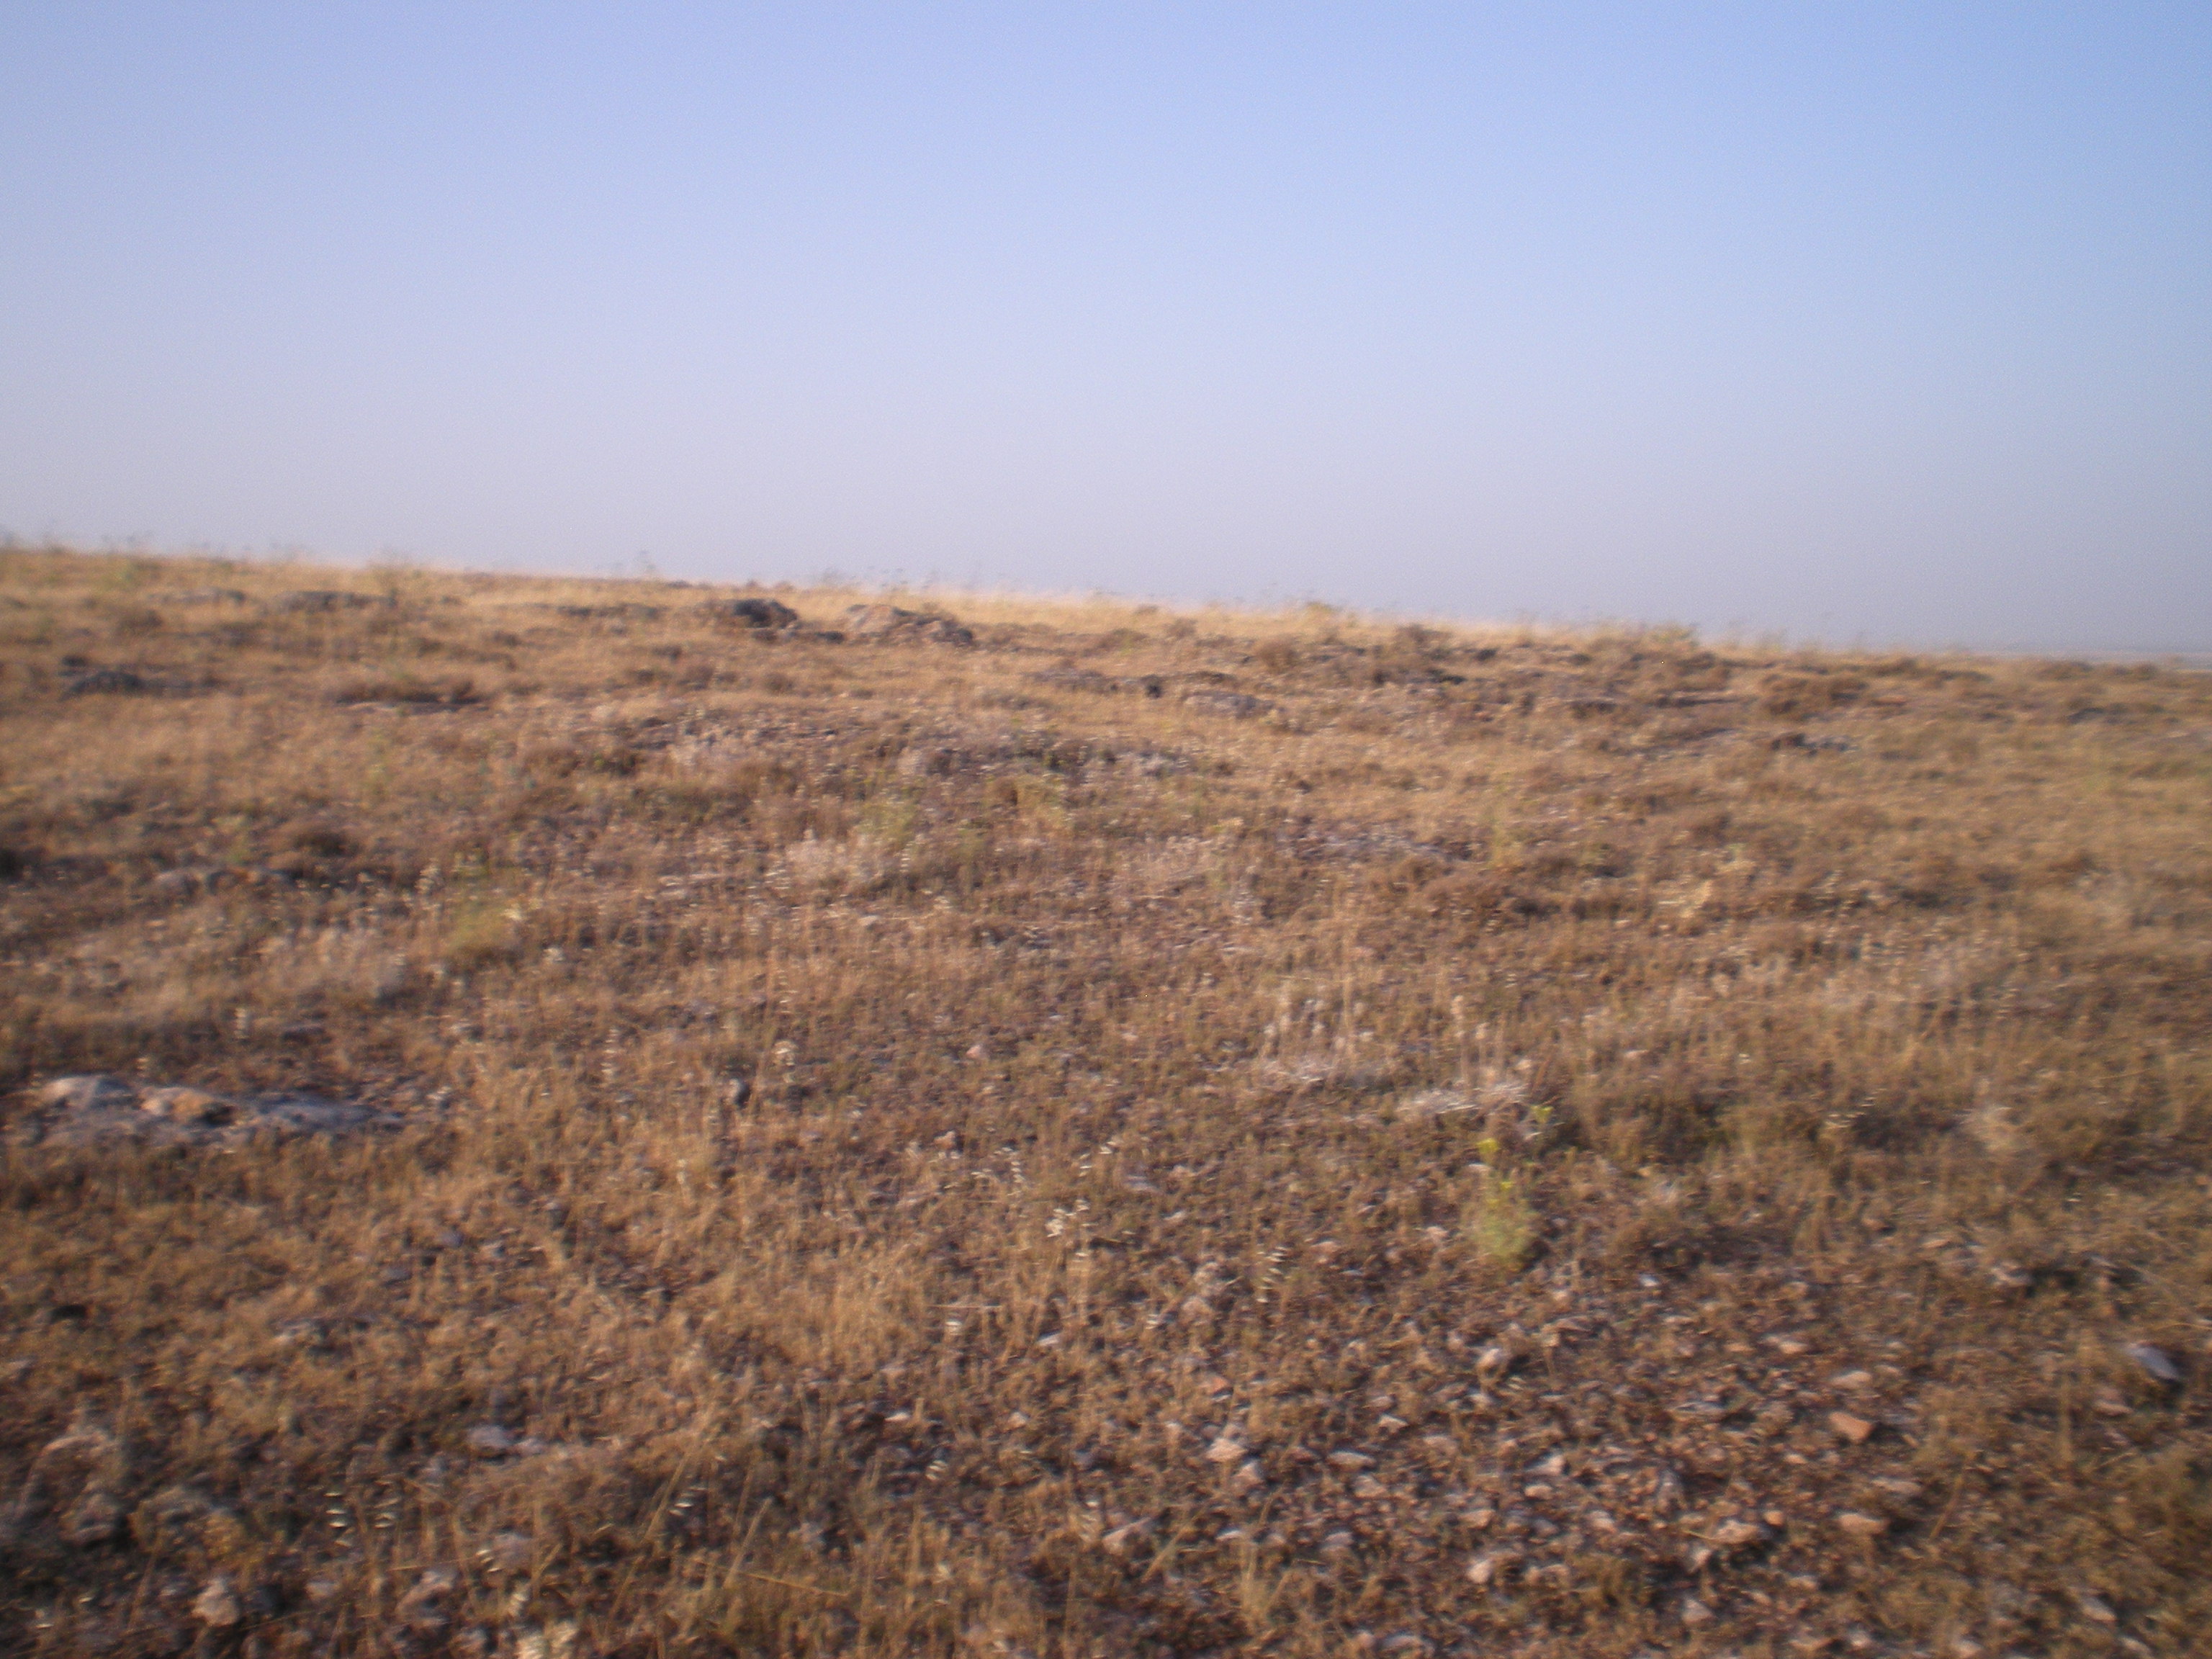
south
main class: Grassland
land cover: Grassland without tree/shrub cover
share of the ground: 25 - 50 %
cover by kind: unconsolidated bare surface 60 %, herbaceous plants 30 %, consolidated bare surface 10 %
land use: Agriculture (excluding fallow land and kitchen gardens)
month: July
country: ES
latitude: 39.4172
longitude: -3.1309
